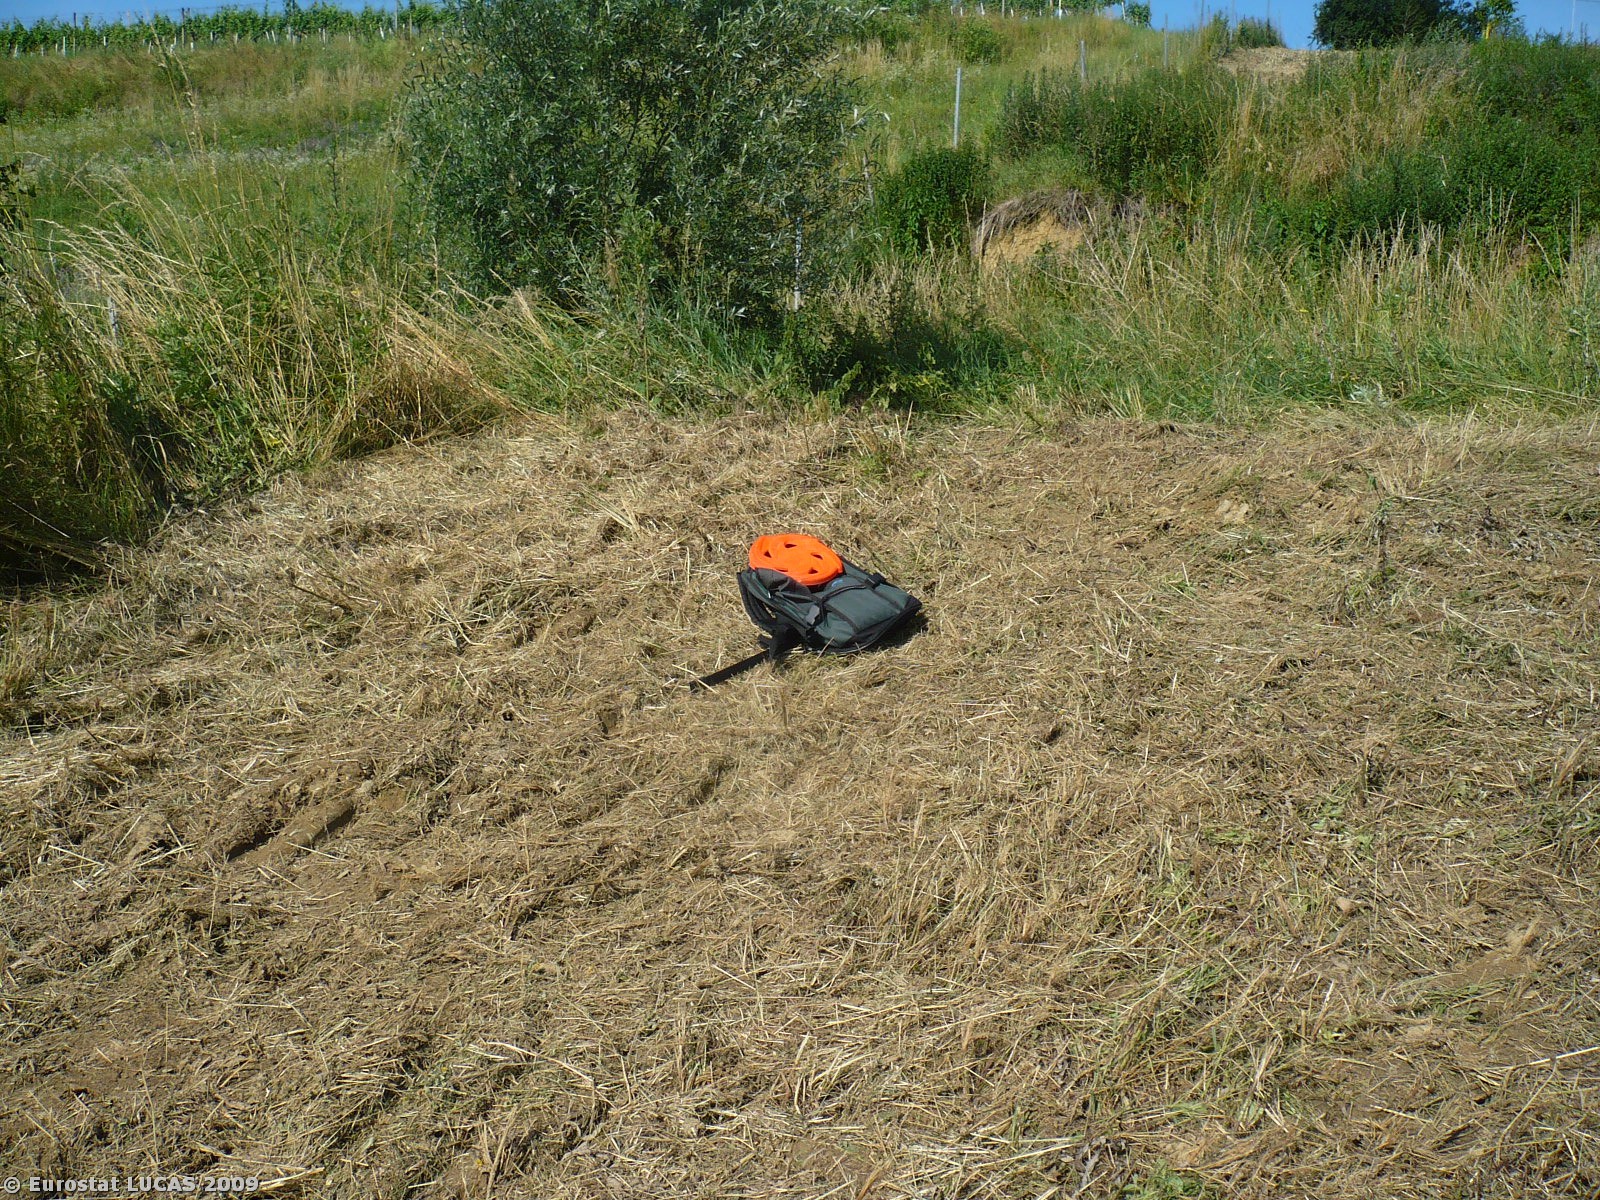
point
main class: Grassland
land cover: Grassland without tree/shrub cover
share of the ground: > 75 %
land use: Agriculture (excluding fallow land and kitchen gardens)
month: June
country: SI
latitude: 46.6136
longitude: 16.0458
